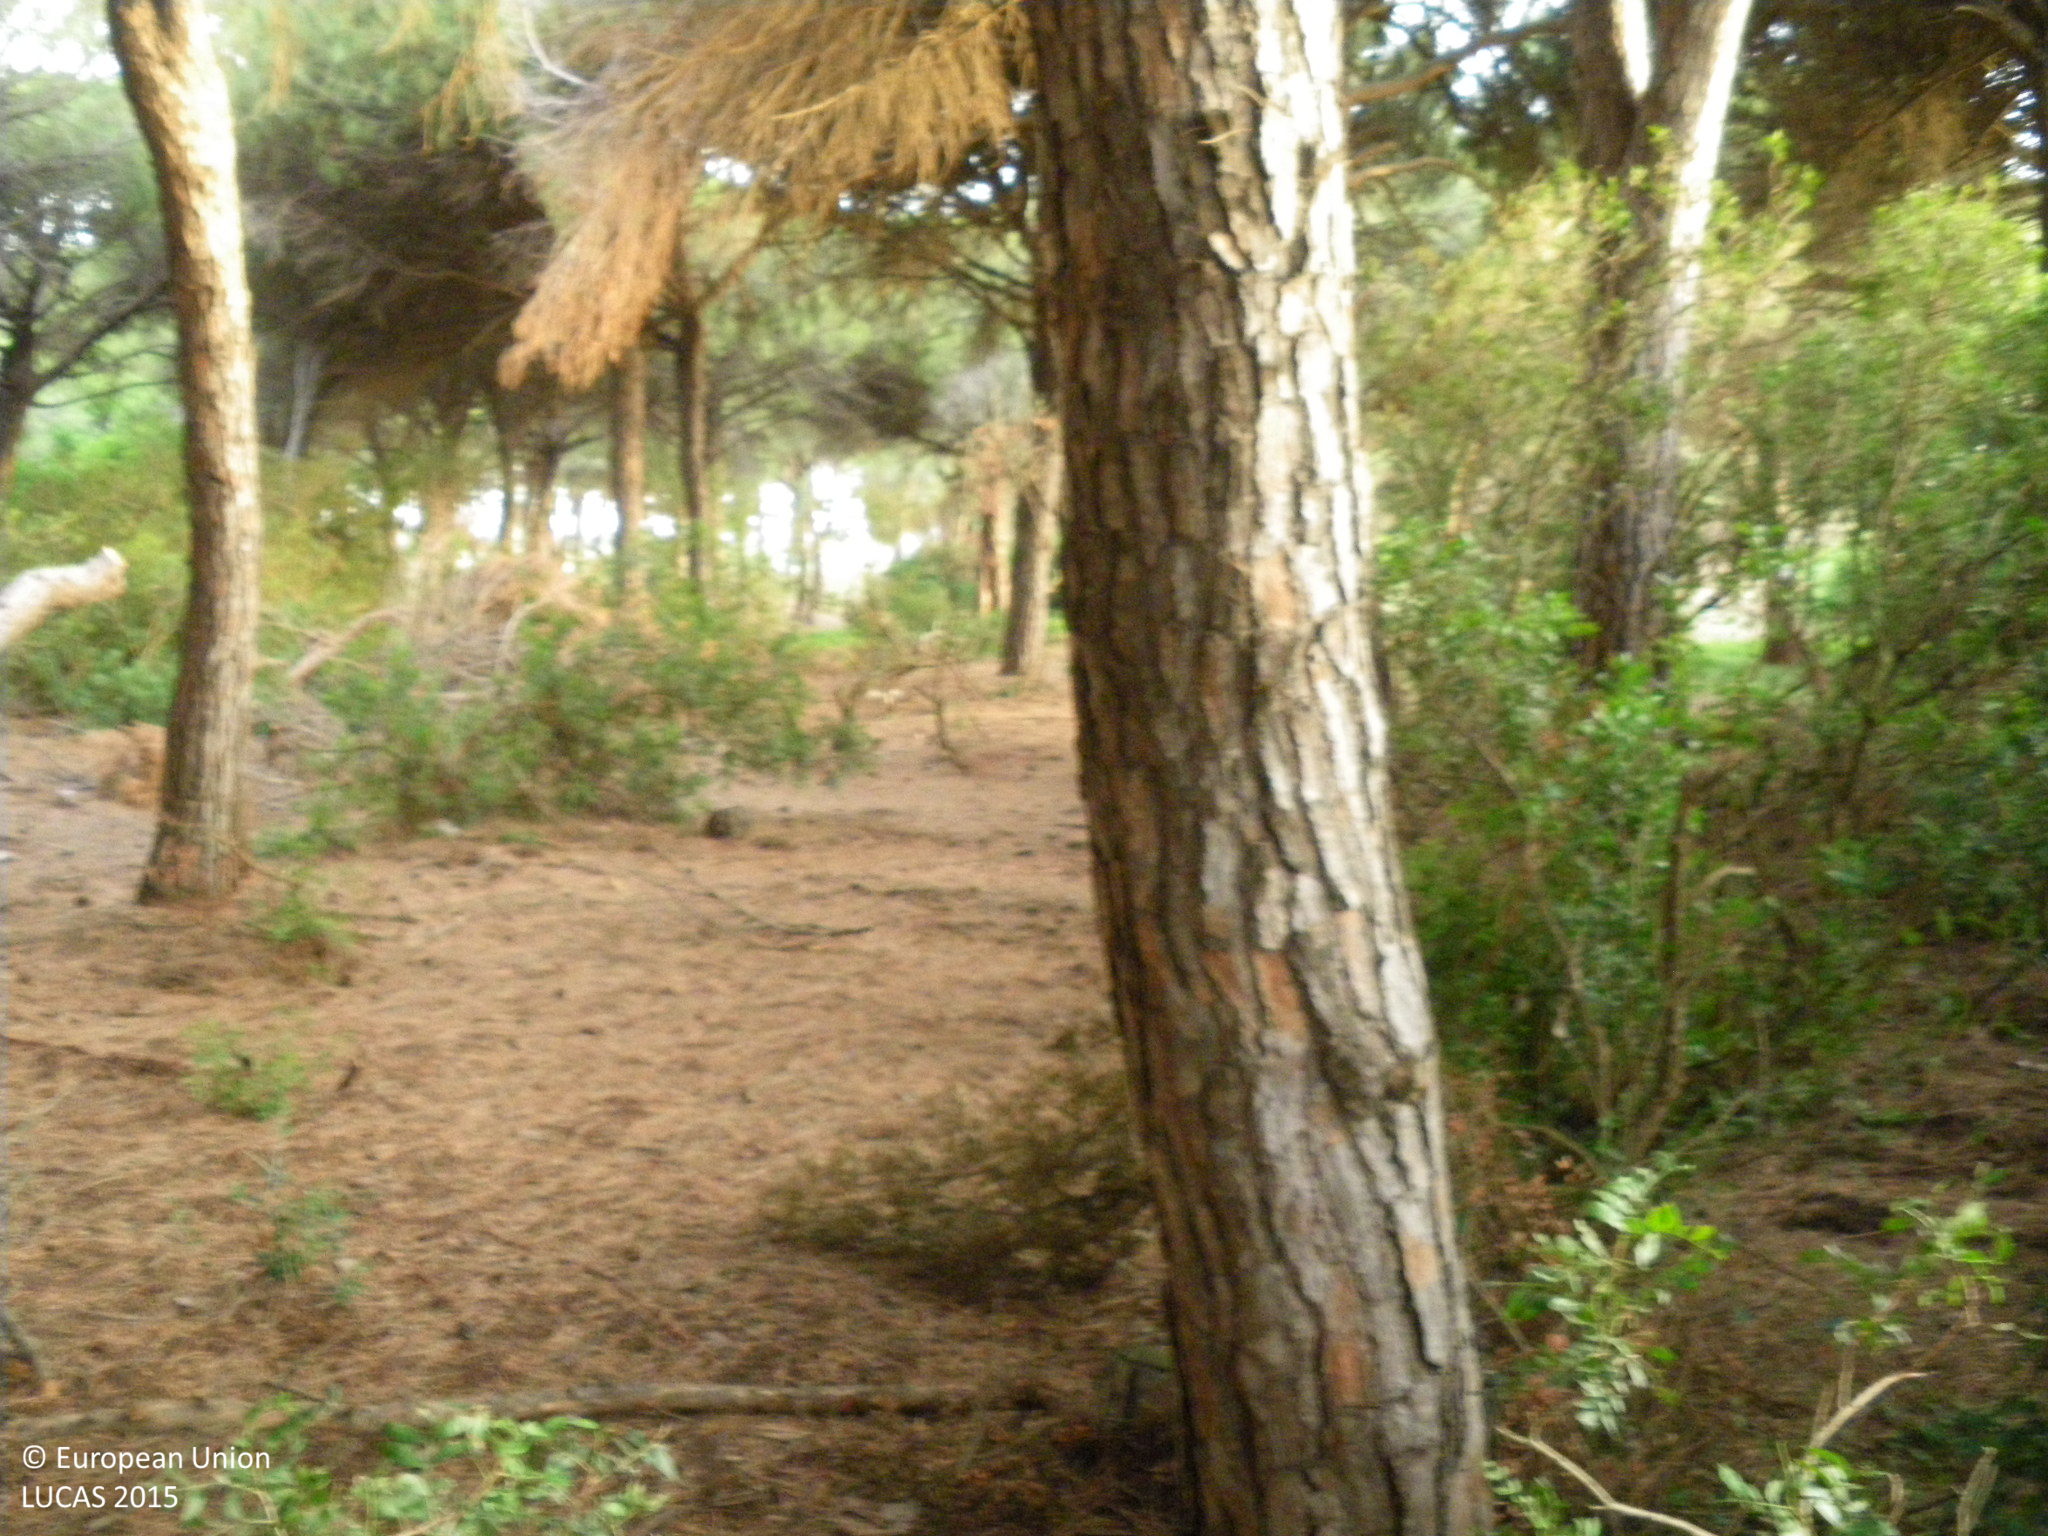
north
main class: Woodland
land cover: Pine dominated coniferous woodland
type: coniferous forest of the mediterranean region
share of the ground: > 75 %
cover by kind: coniferous forest trees 100 %
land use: Forestry
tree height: > 5 m
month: June
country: ES
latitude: 36.5492
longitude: -6.1070
